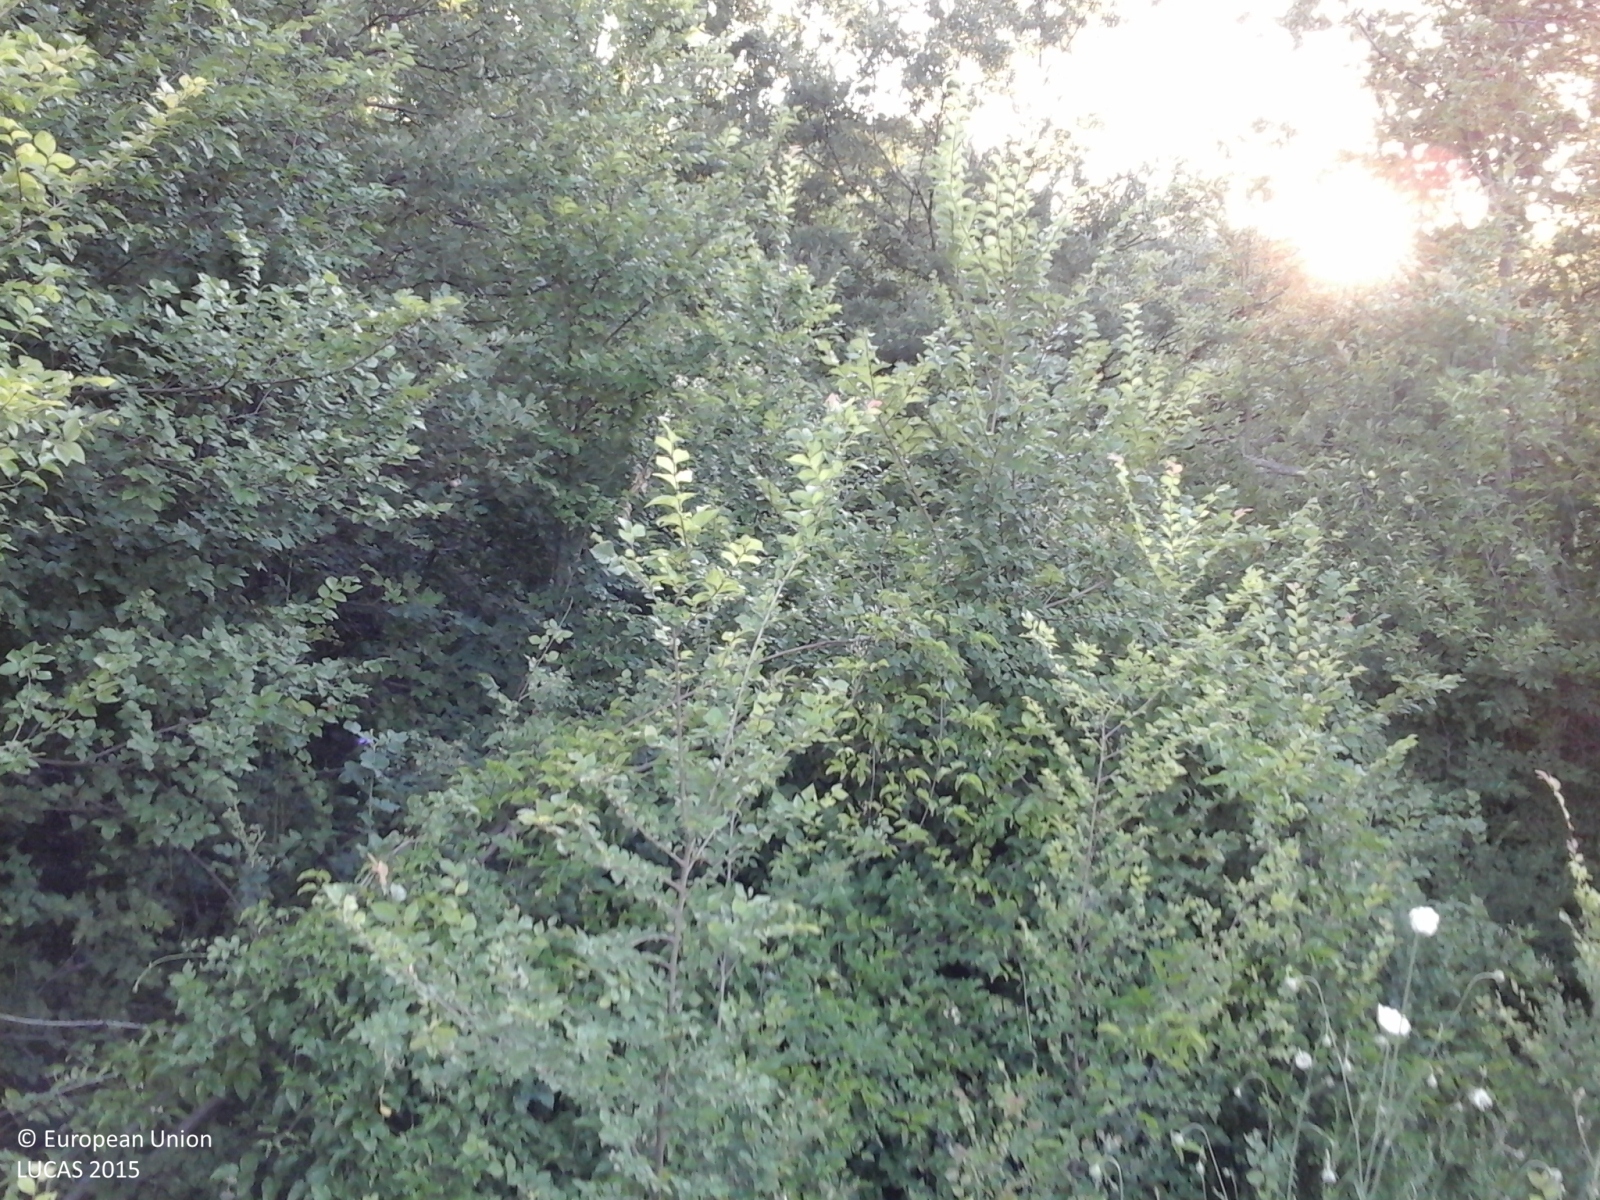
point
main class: Woodland
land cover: Broadleaved woodland
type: thermophilous deciduous forest
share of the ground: > 75 %
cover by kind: broadleaved forest trees 90 %, shrubs 10 %
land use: Semi-natural and natural areas not in use
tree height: > 5 m
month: July
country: IT
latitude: 41.6051
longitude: 14.6755
